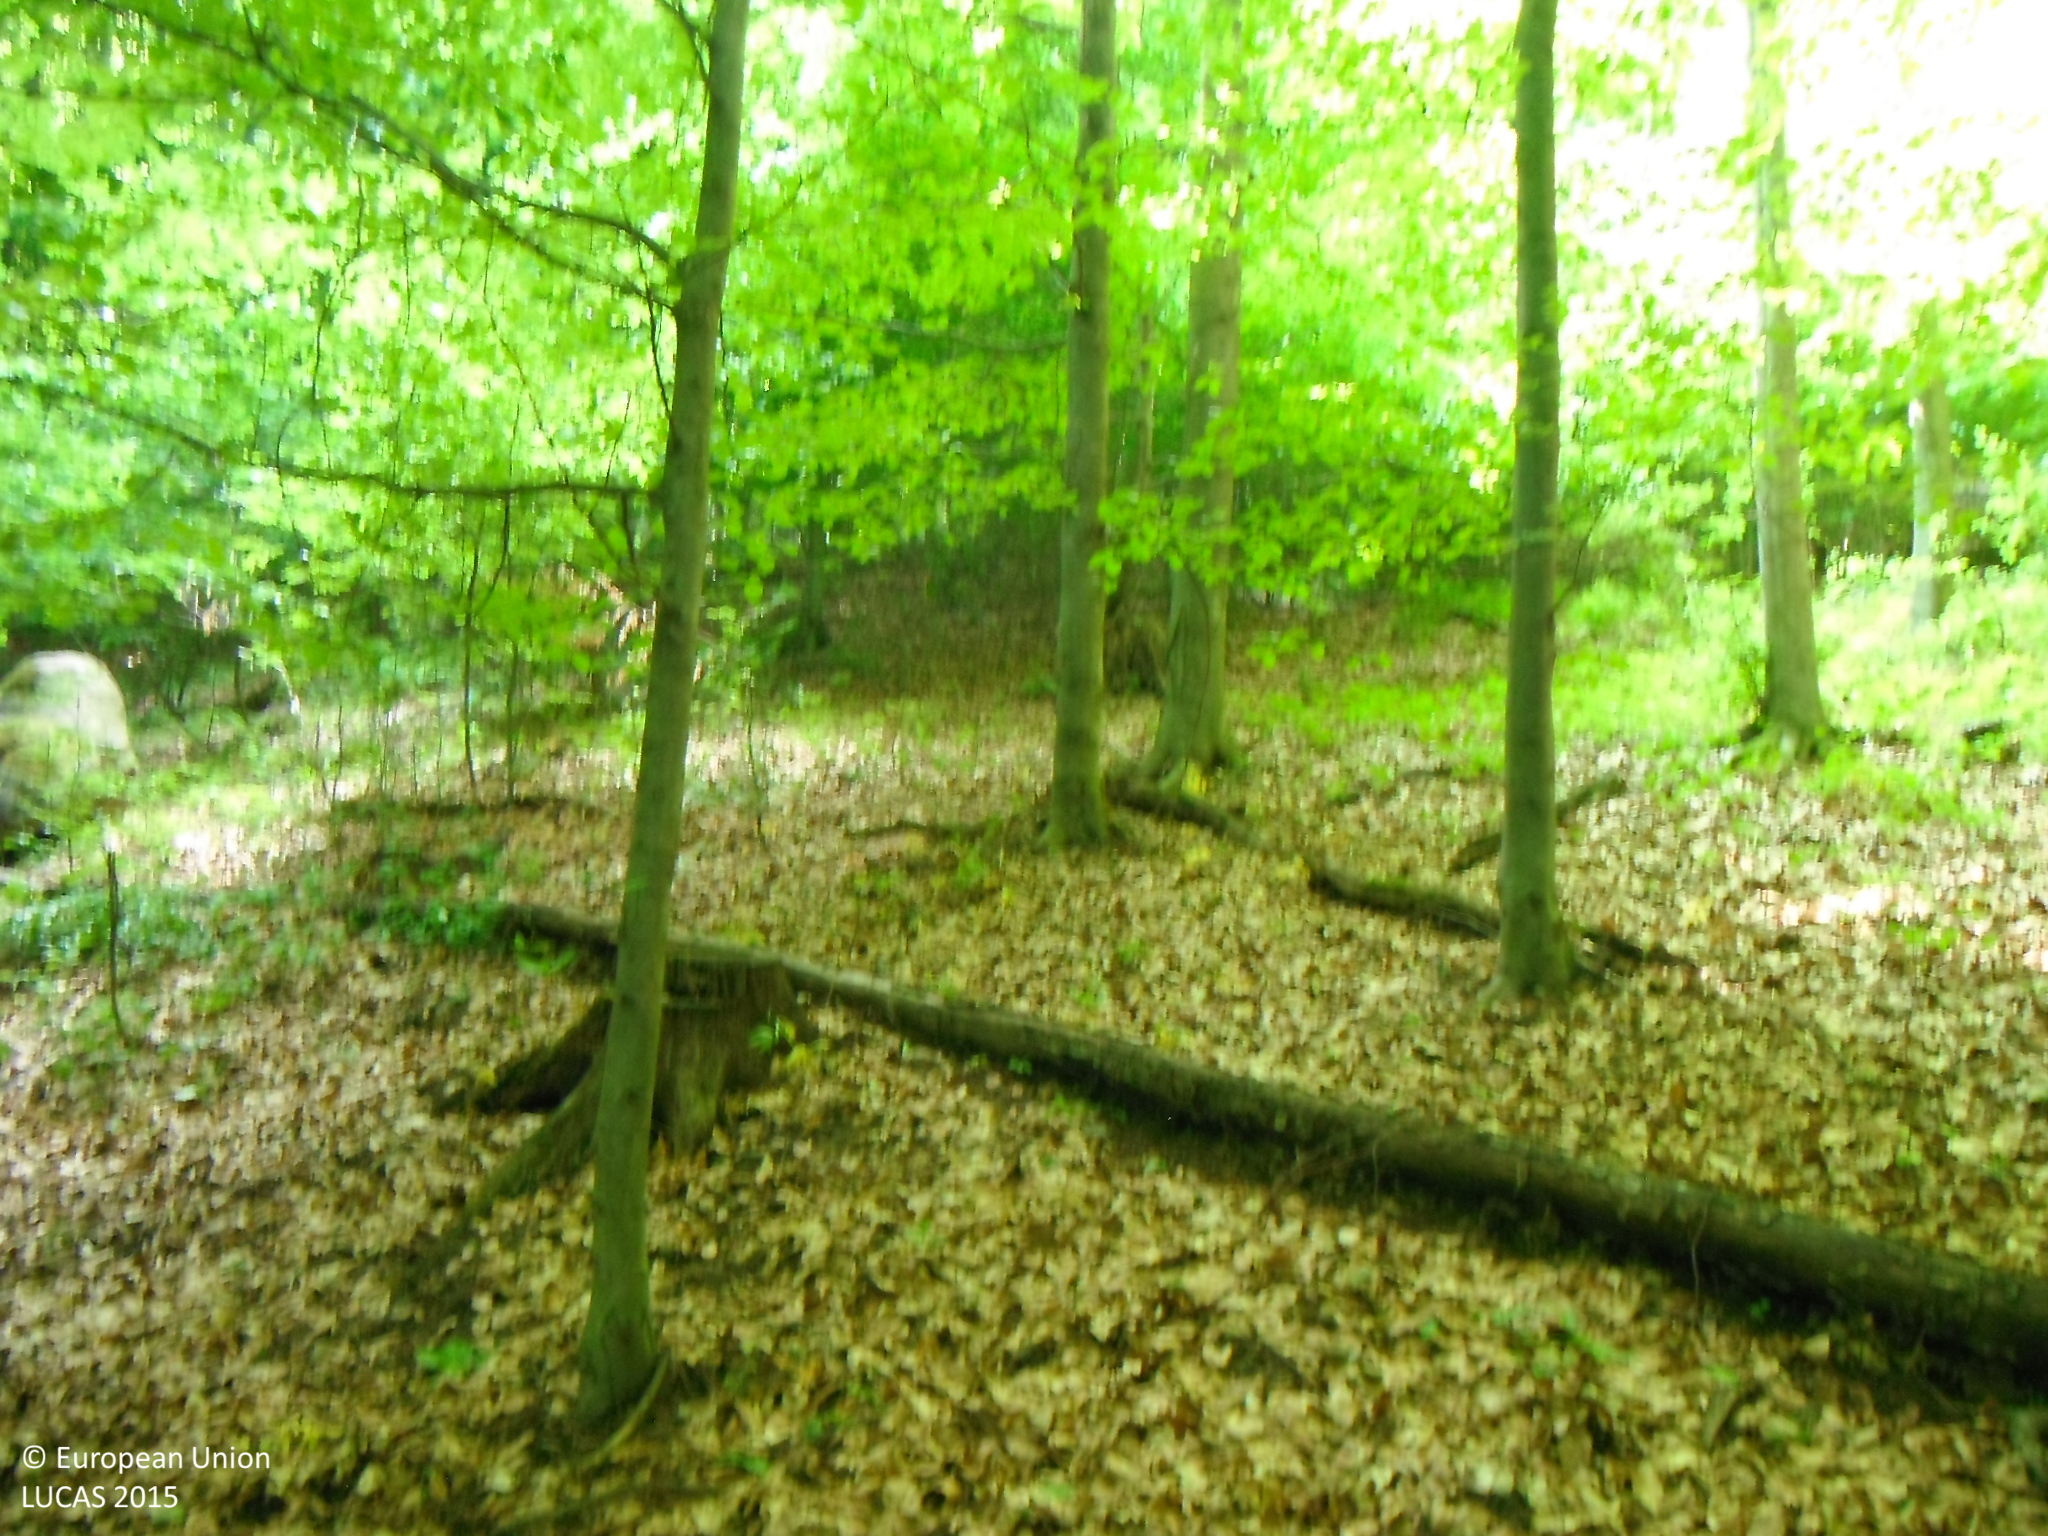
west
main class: Woodland
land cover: Broadleaved woodland
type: beech forest
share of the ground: > 75 %
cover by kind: broadleaved forest trees 100 %
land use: Forestry
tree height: > 5 m
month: June
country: SK
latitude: 48.5492
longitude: 19.3575
